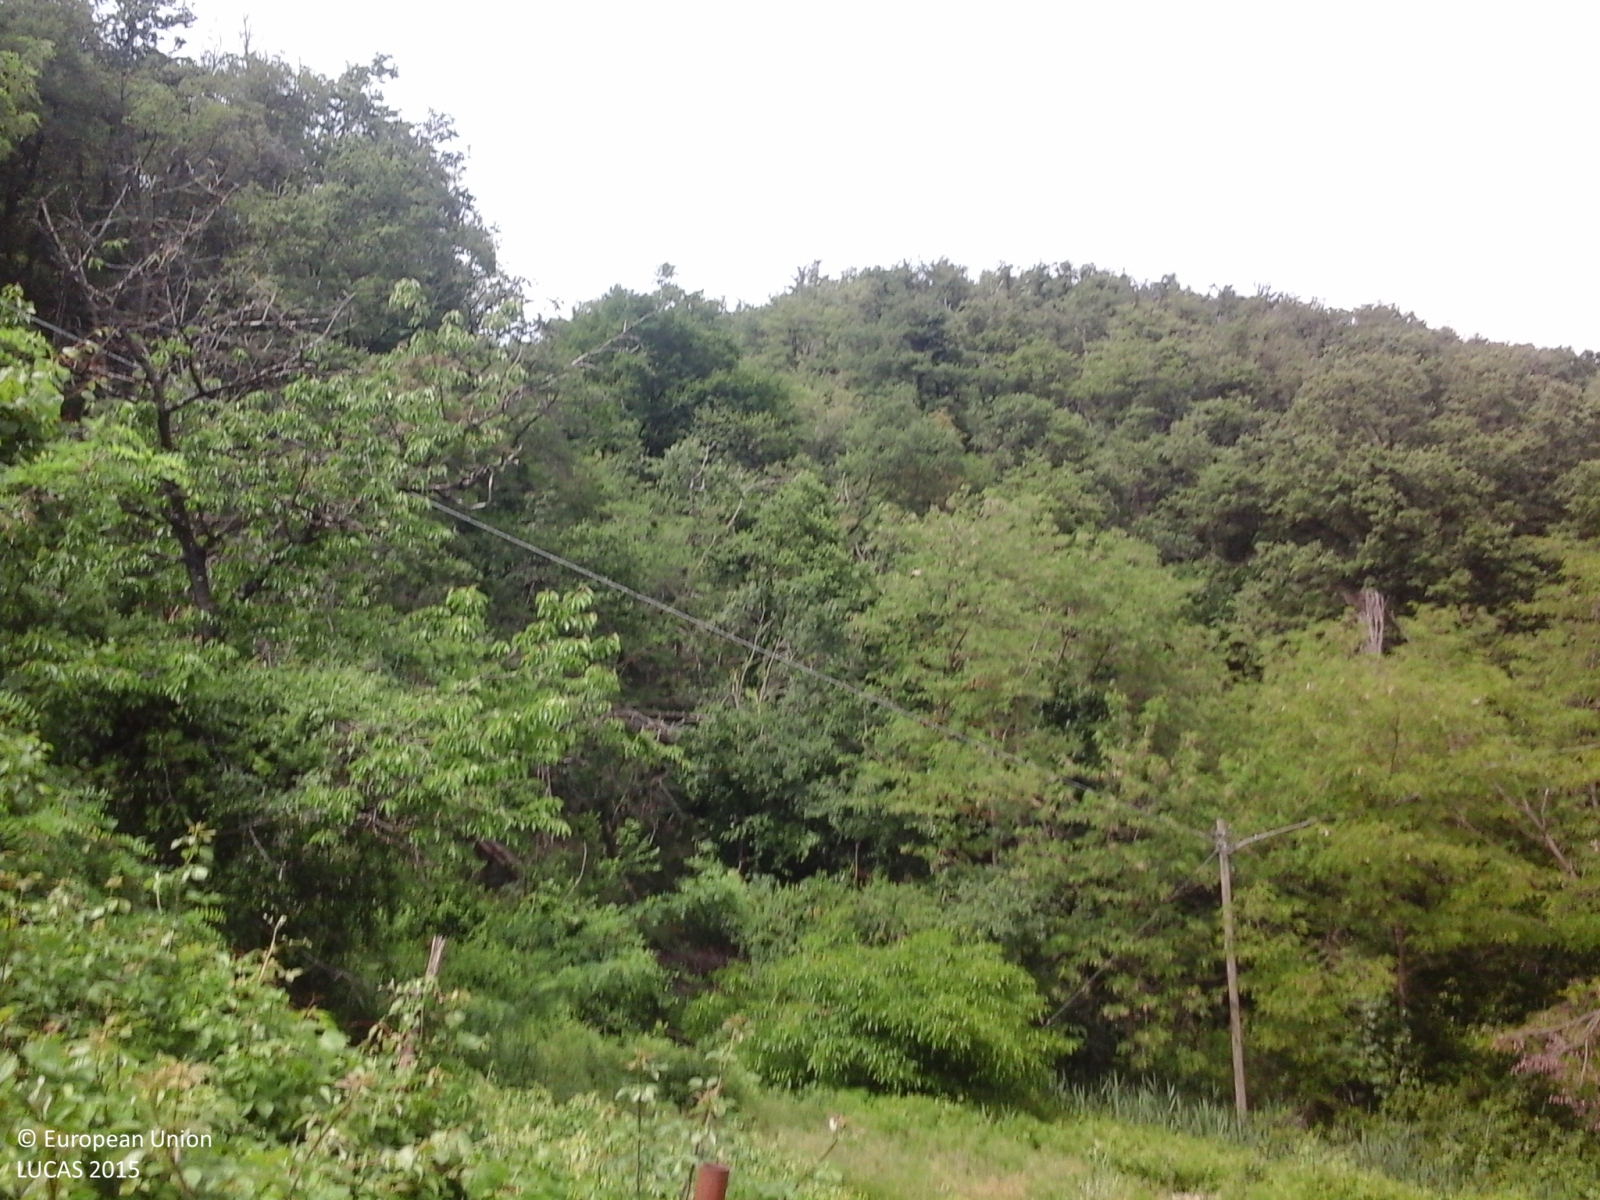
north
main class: Woodland
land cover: Broadleaved woodland
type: thermophilous deciduous forest
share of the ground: > 75 %
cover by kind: broadleaved forest trees 80 %, shrubs 15 %, herbaceous plants 5 %
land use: Forestry
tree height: > 5 m
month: May
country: IT
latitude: 44.2716
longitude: 11.1874
